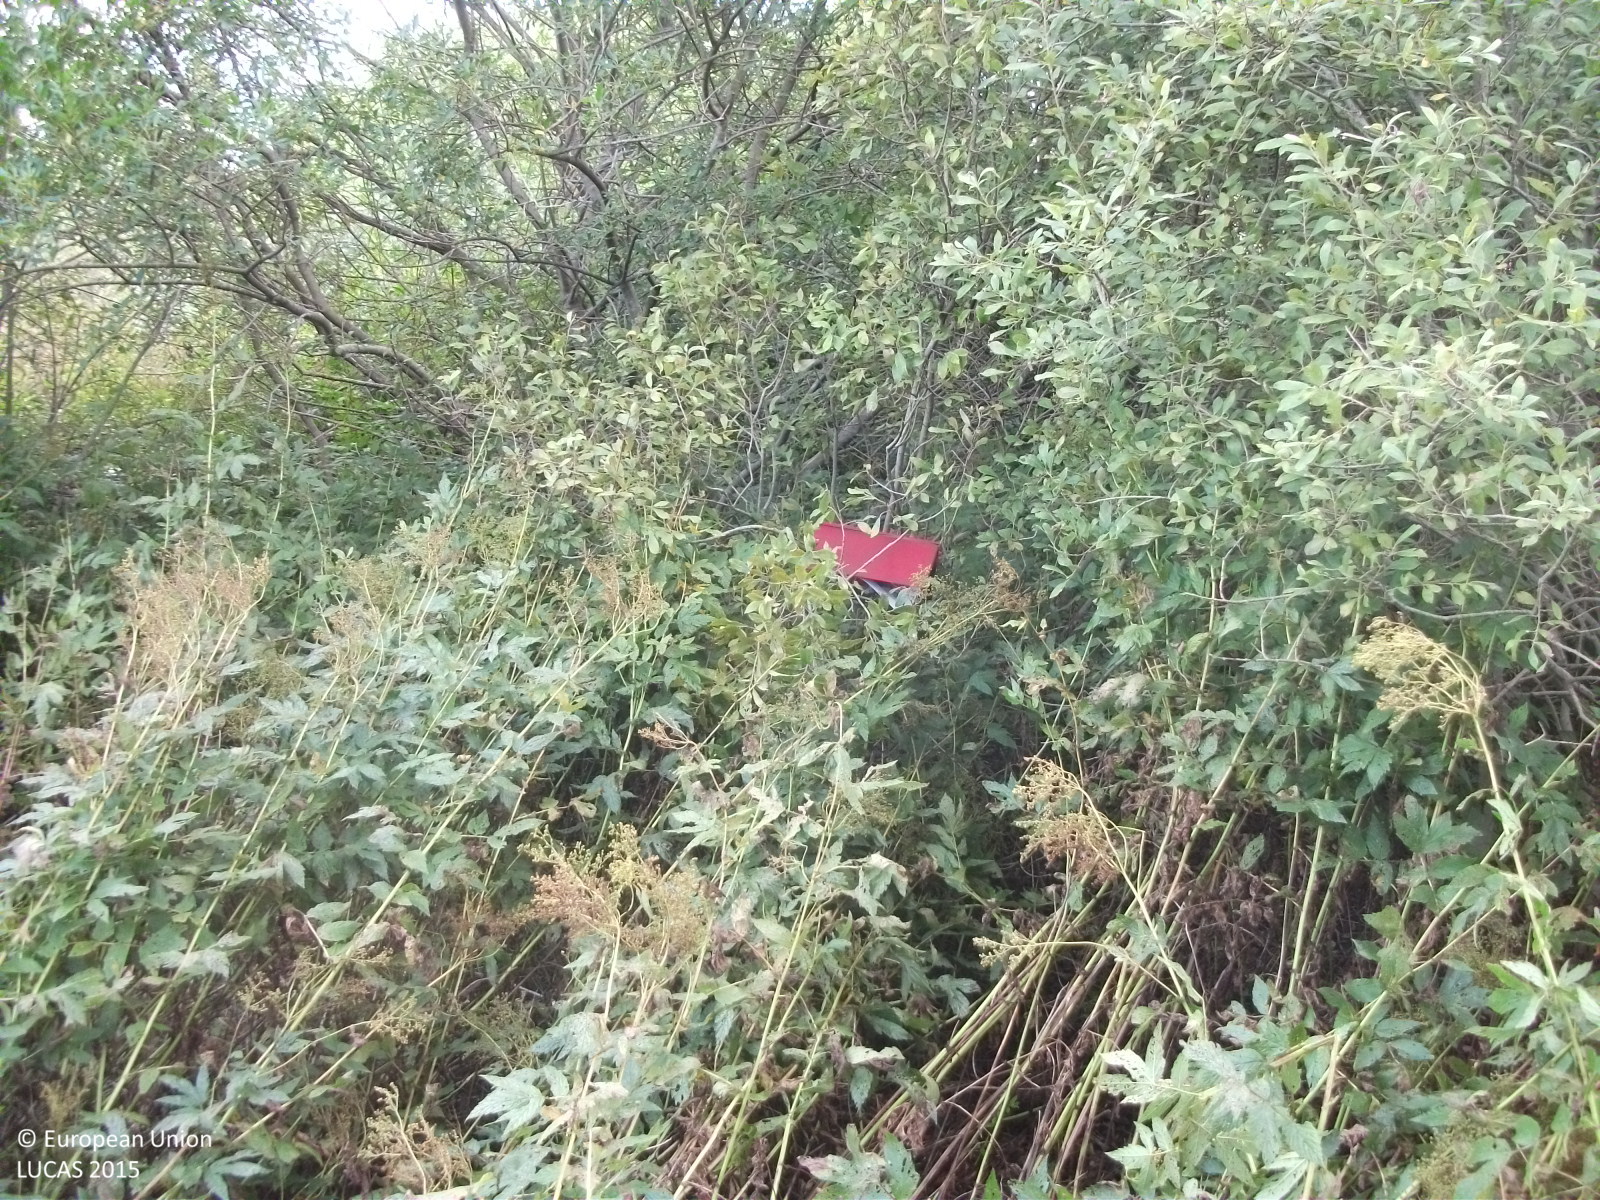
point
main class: Woodland
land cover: Broadleaved woodland
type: mire and swamp forests
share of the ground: 50 - 75 %
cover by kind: broadleaved forest trees 50 %, shrubs 45 %, herbaceous plants 5 %
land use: Semi-natural and natural areas not in use
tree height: > 5 m
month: September
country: LV
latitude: 57.4625
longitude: 24.5111
